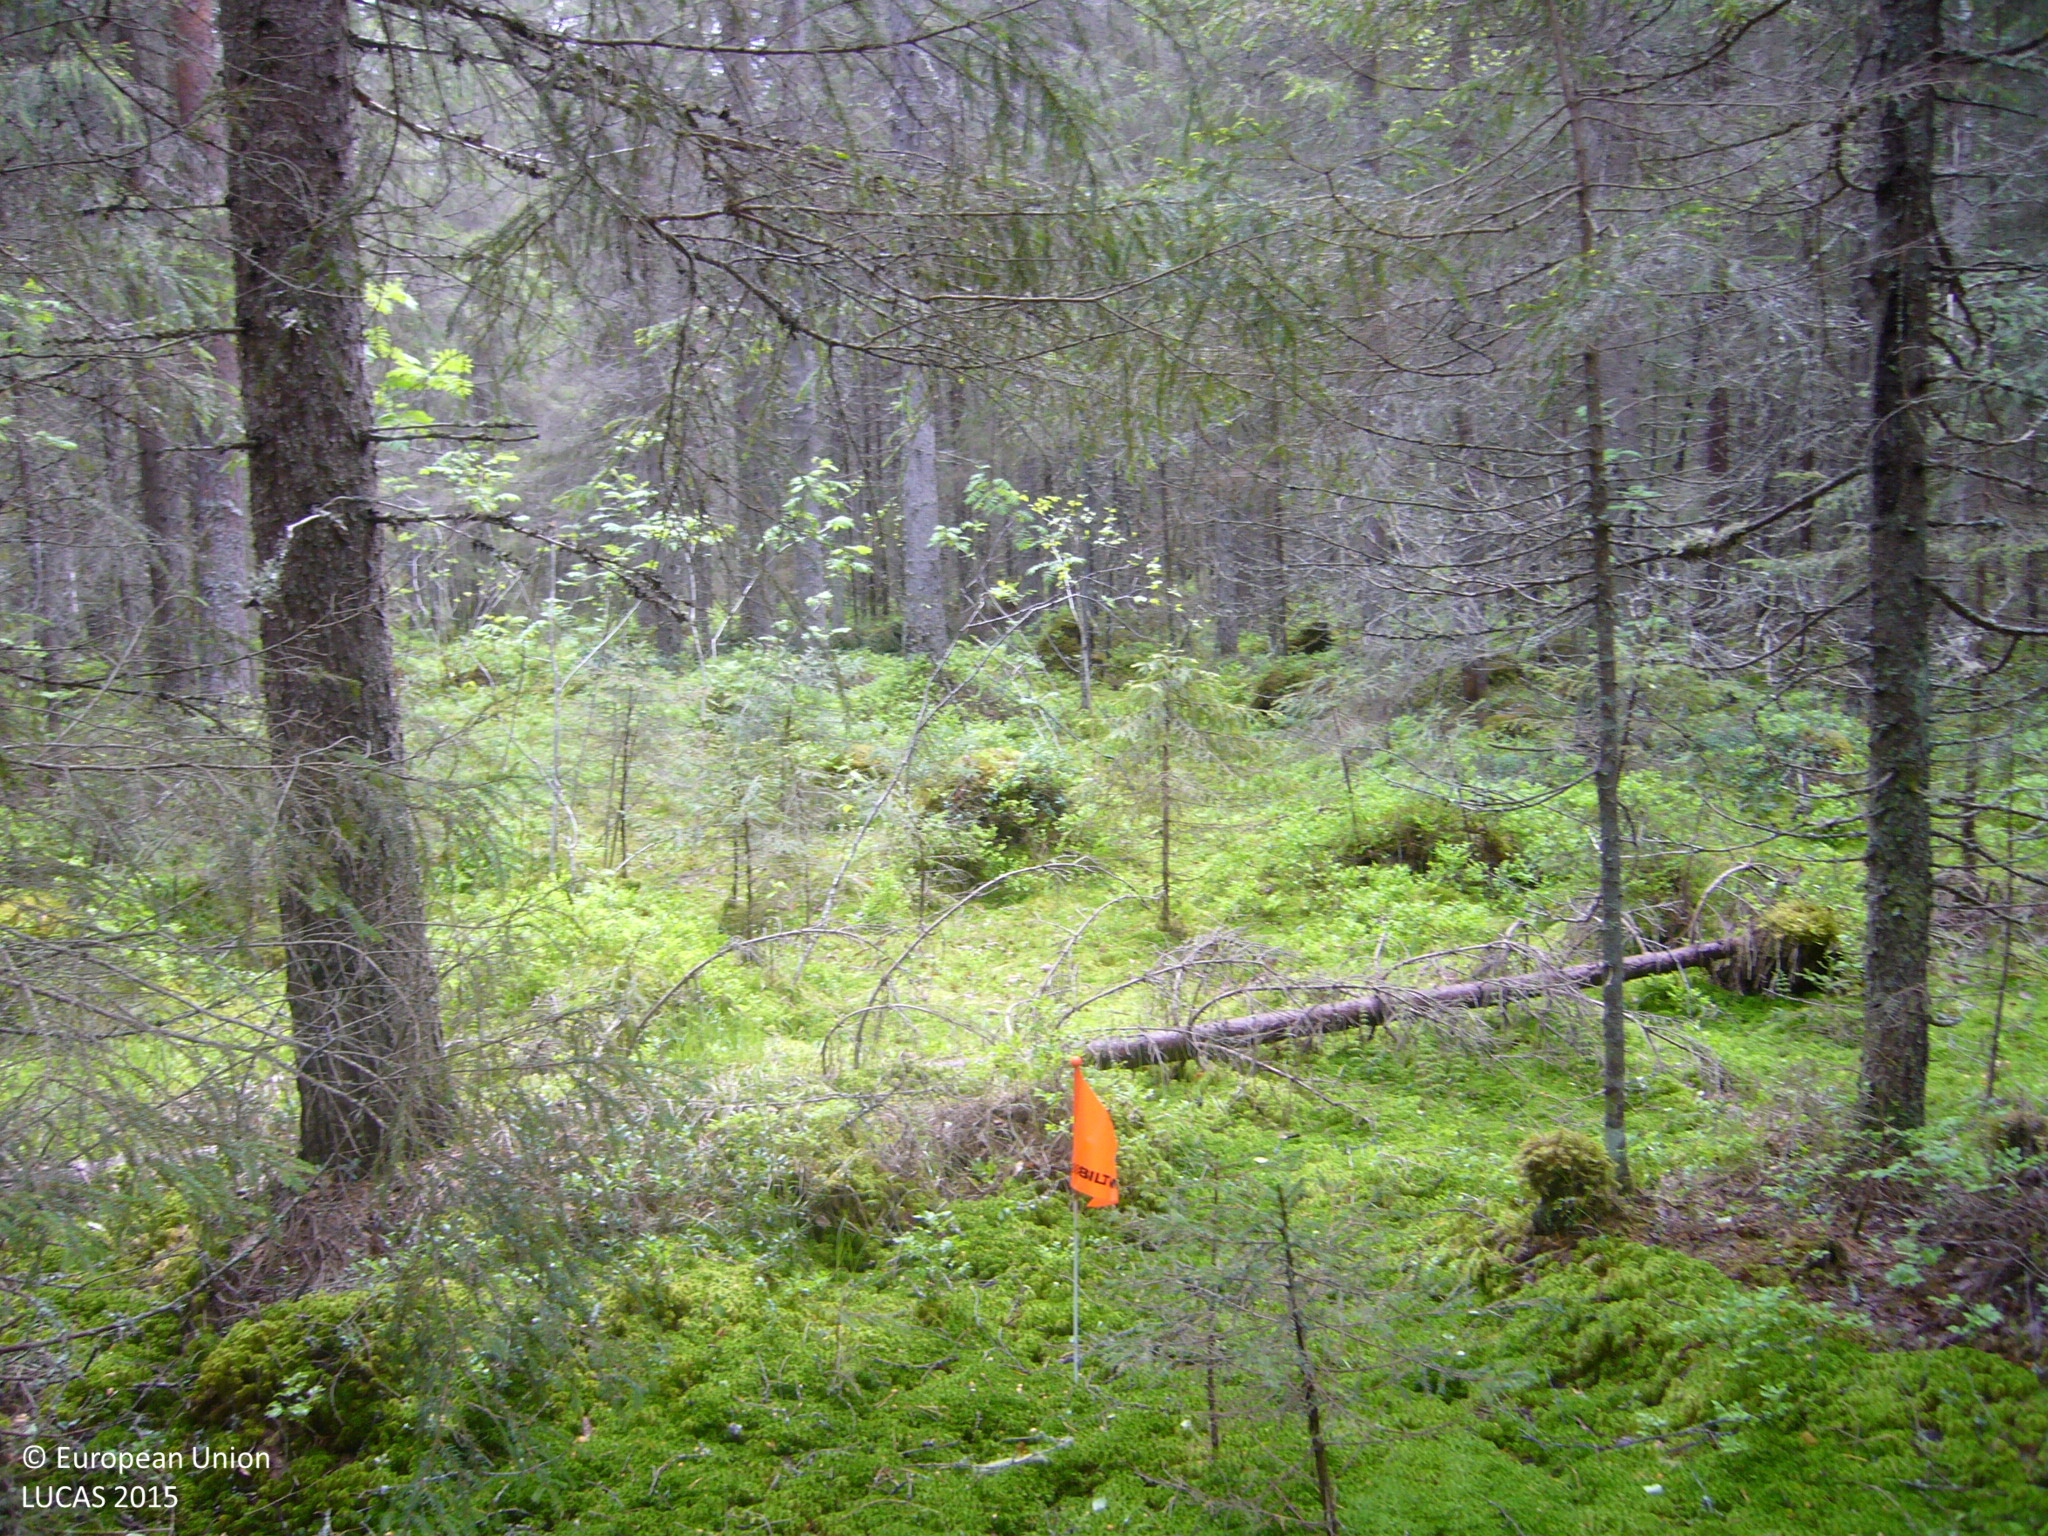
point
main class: Woodland
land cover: Spruce dominated mixed woodland
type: boreal forest
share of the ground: > 75 %
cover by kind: coniferous forest trees 60 %, broadleaved forest trees 30 %, shrubs 10 %
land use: Forestry
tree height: > 5 m
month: June
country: FI
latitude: 63.2396
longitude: 26.2269
